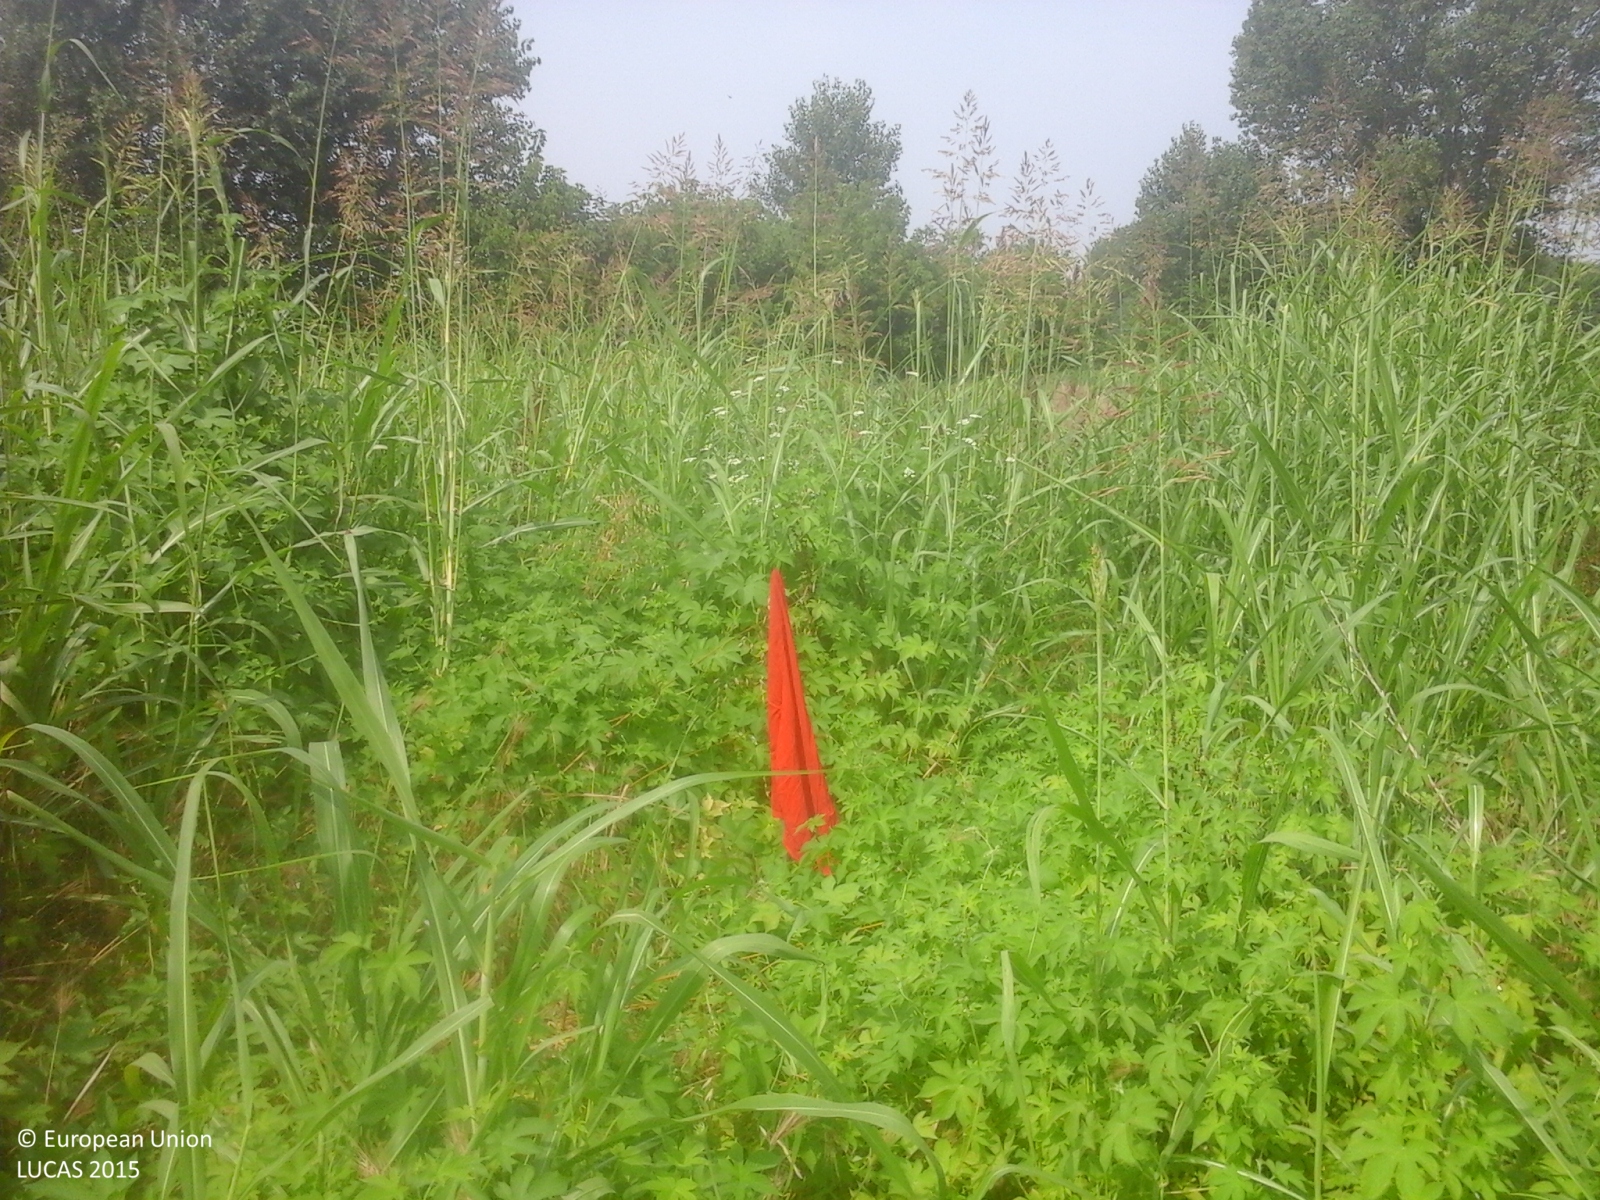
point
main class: Grassland
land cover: Spontaneously vegetated surfaces
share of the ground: > 75 %
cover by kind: herbaceous plants 100 %
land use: Agriculture (excluding fallow land and kitchen gardens)
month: July
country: IT
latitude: 45.1767
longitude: 9.1744
